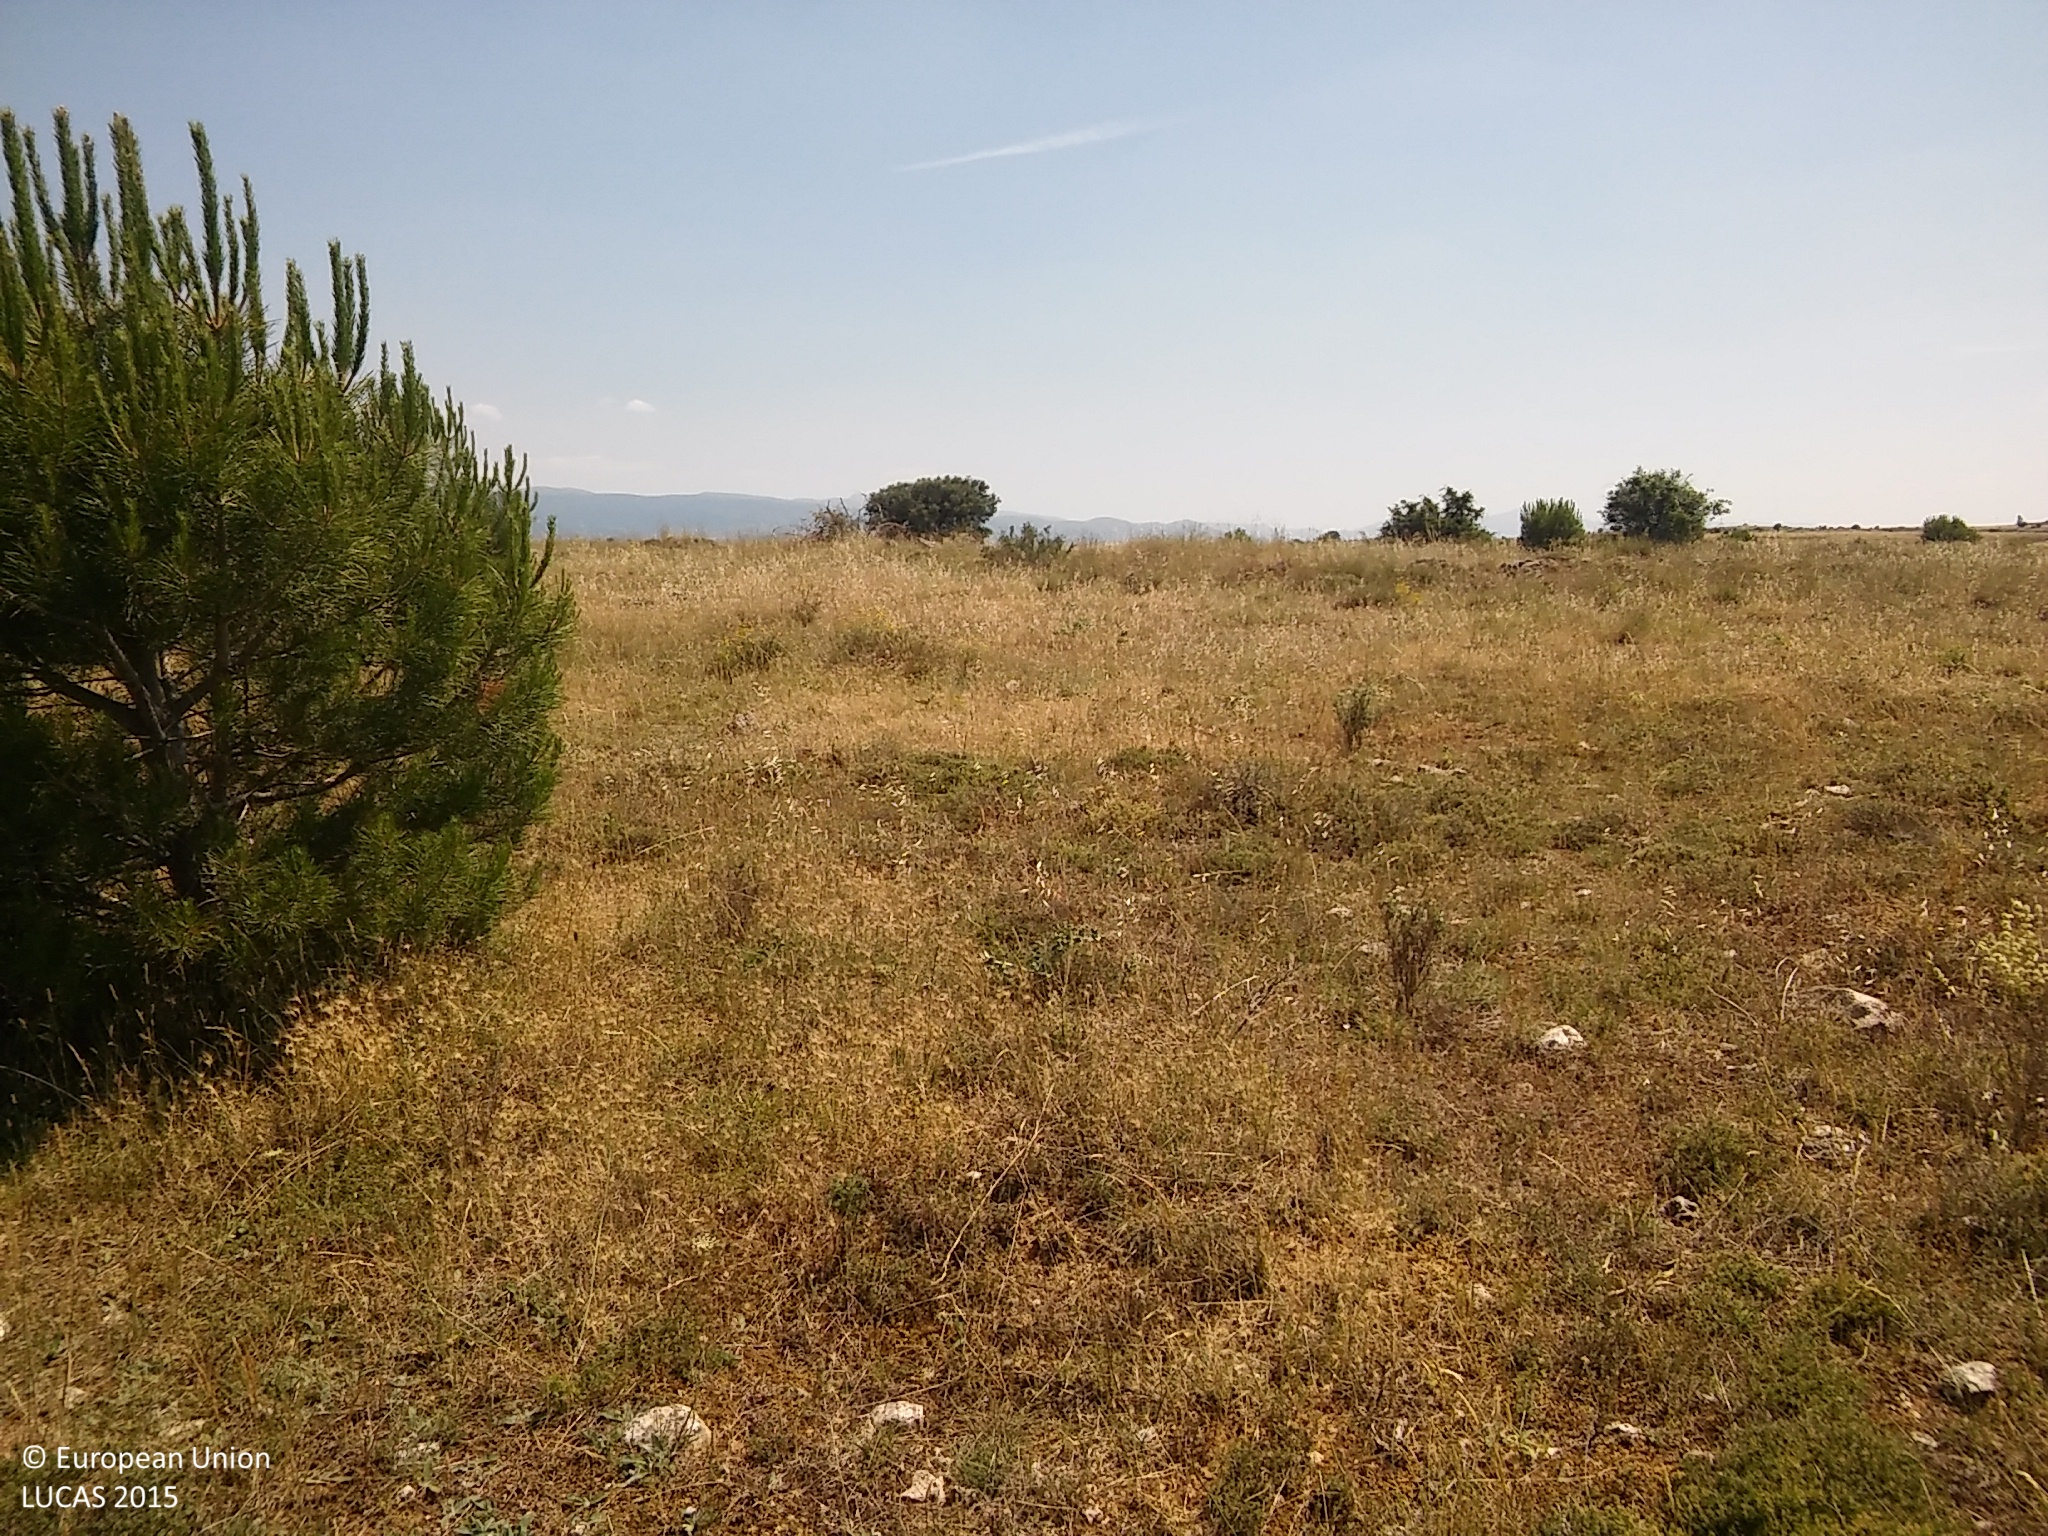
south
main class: Woodland
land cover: Pine dominated coniferous woodland
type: coniferous forest of the mediterranean region
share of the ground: 10 - 25 %
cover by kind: herbaceous plants 65 %, shrubs 25 %, coniferous forest trees 10 %
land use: Forestry
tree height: < 5 m
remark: Nursery
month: June
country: ES
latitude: 41.1128
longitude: -3.9716
